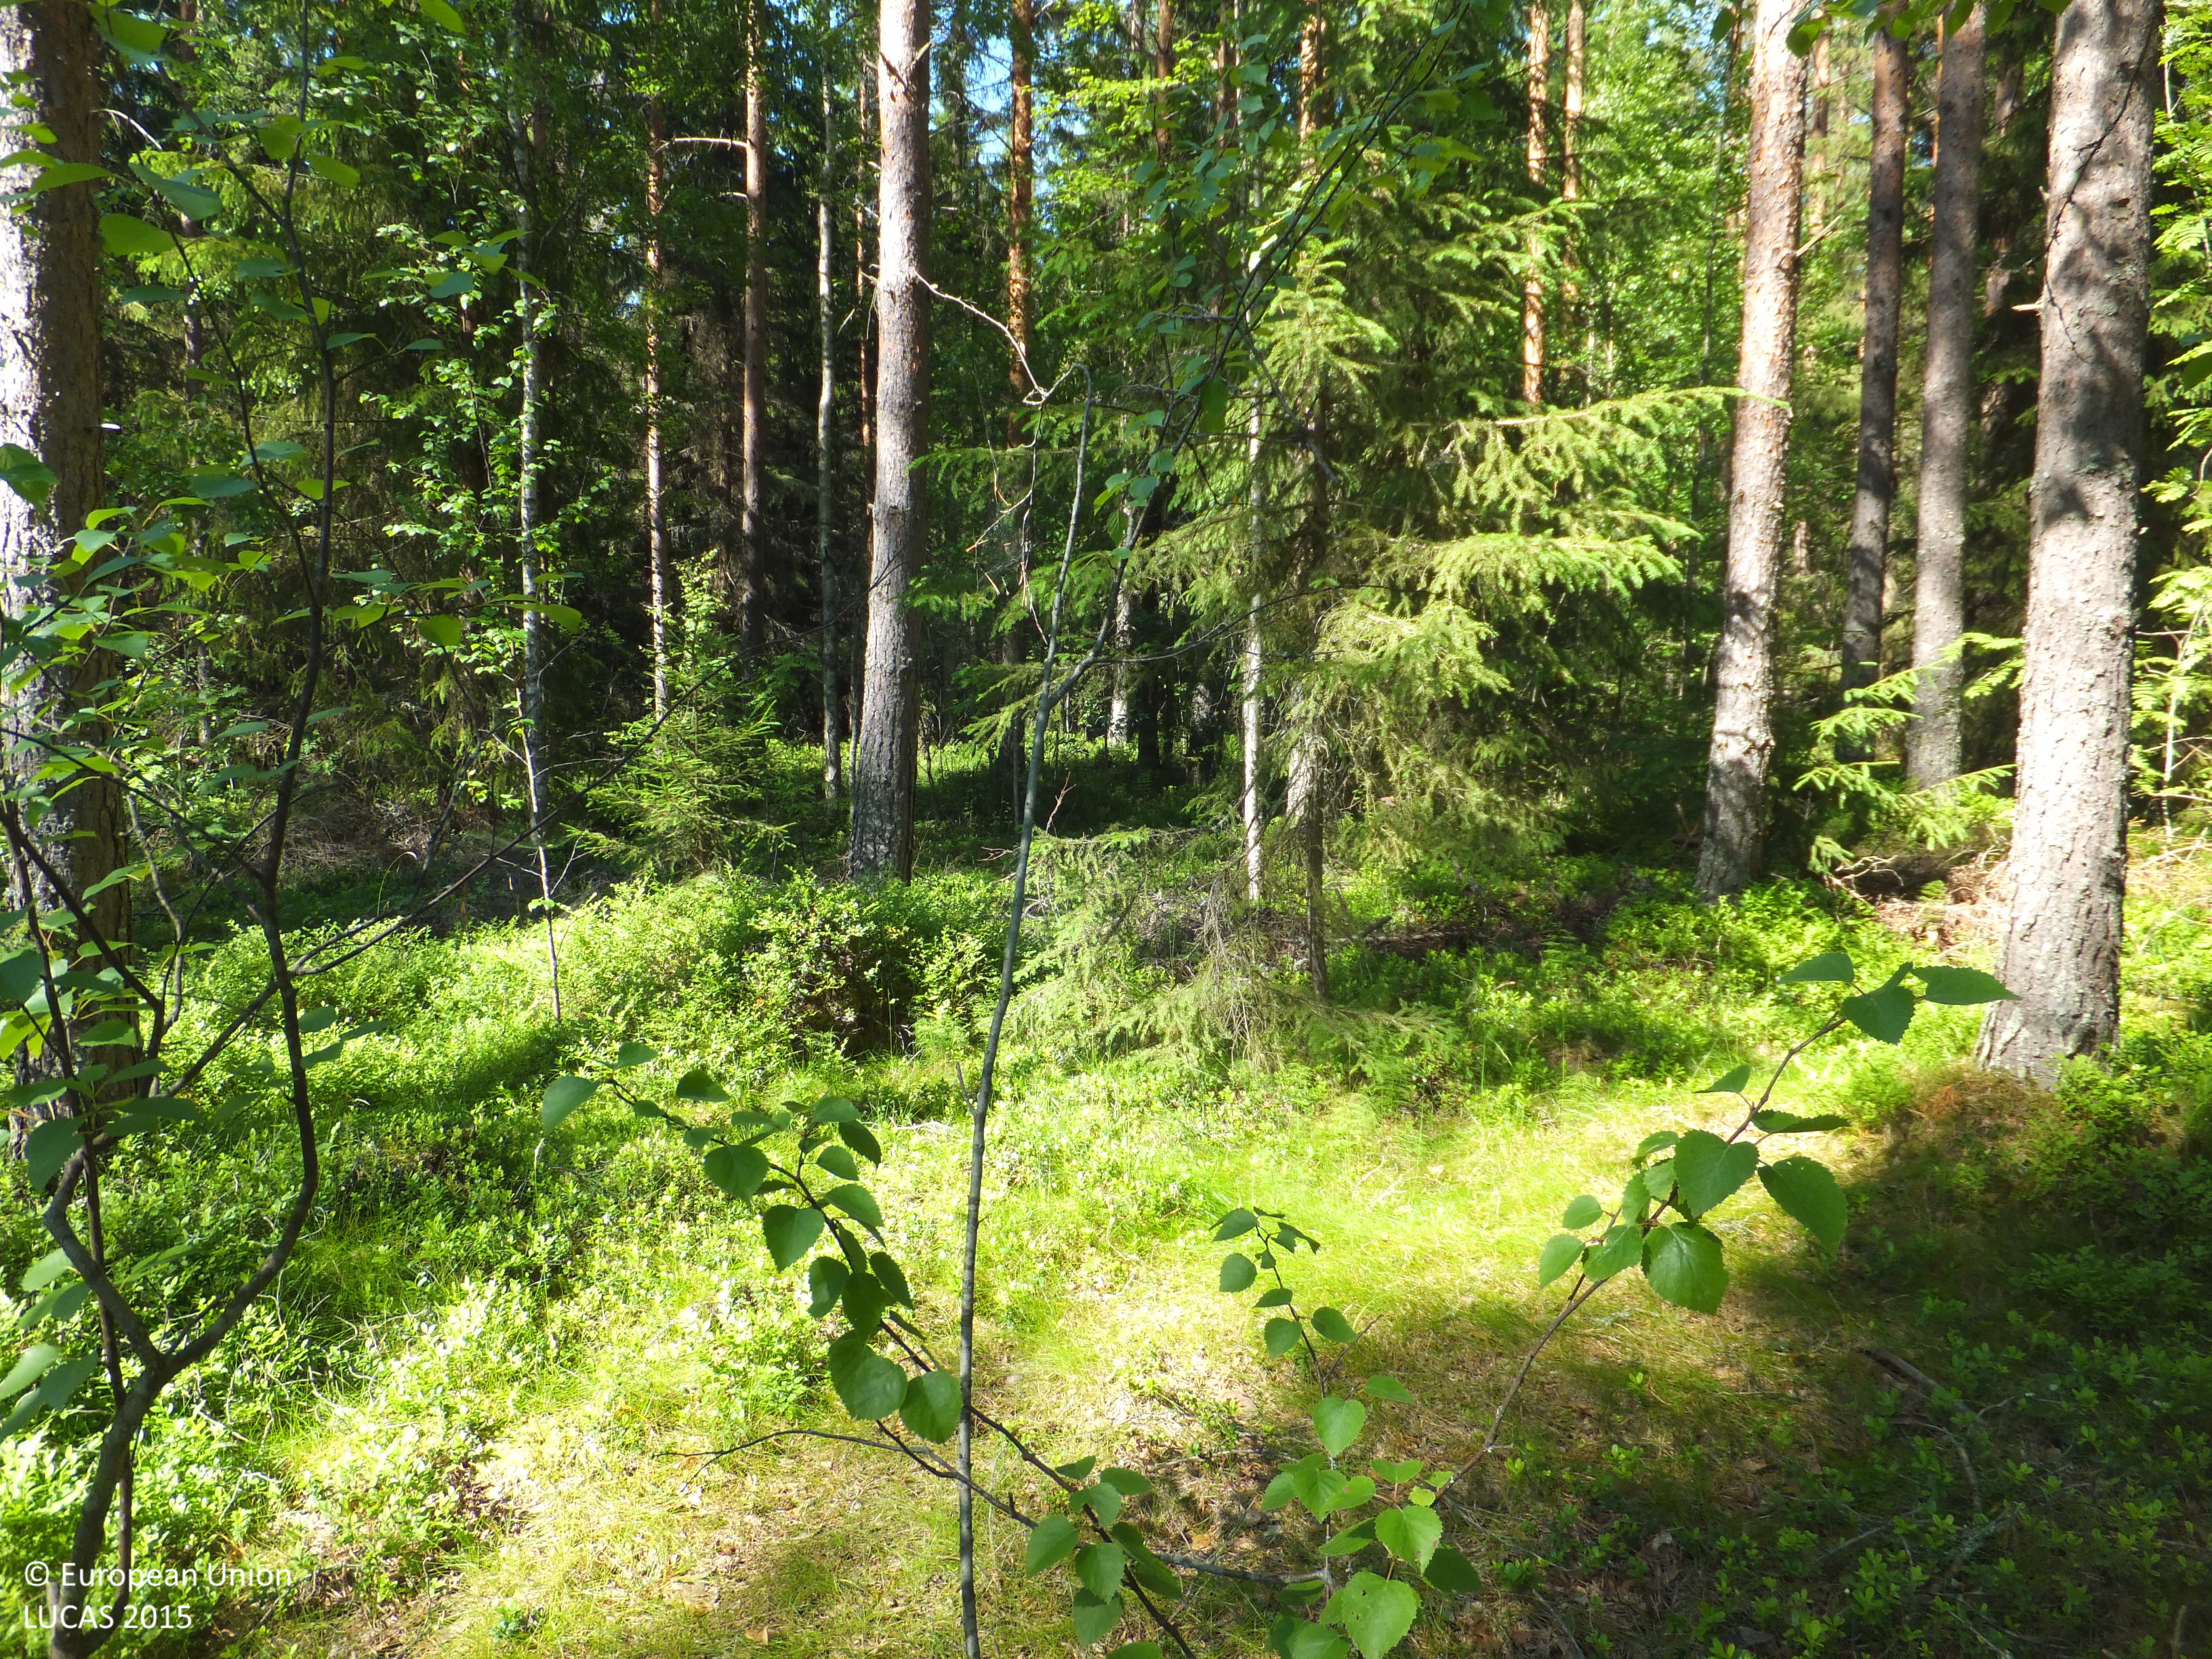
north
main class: Woodland
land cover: Pine dominated mixed woodland
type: boreal forest
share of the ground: > 75 %
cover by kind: coniferous forest trees 60 %, broadleaved forest trees 20 %, shrubs 10 %, herbaceous plants 5 %, lichens and mosses 5 %
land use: Forestry
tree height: > 5 m
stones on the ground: < 10 %
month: July
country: FI
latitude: 63.1603
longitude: 23.8690
